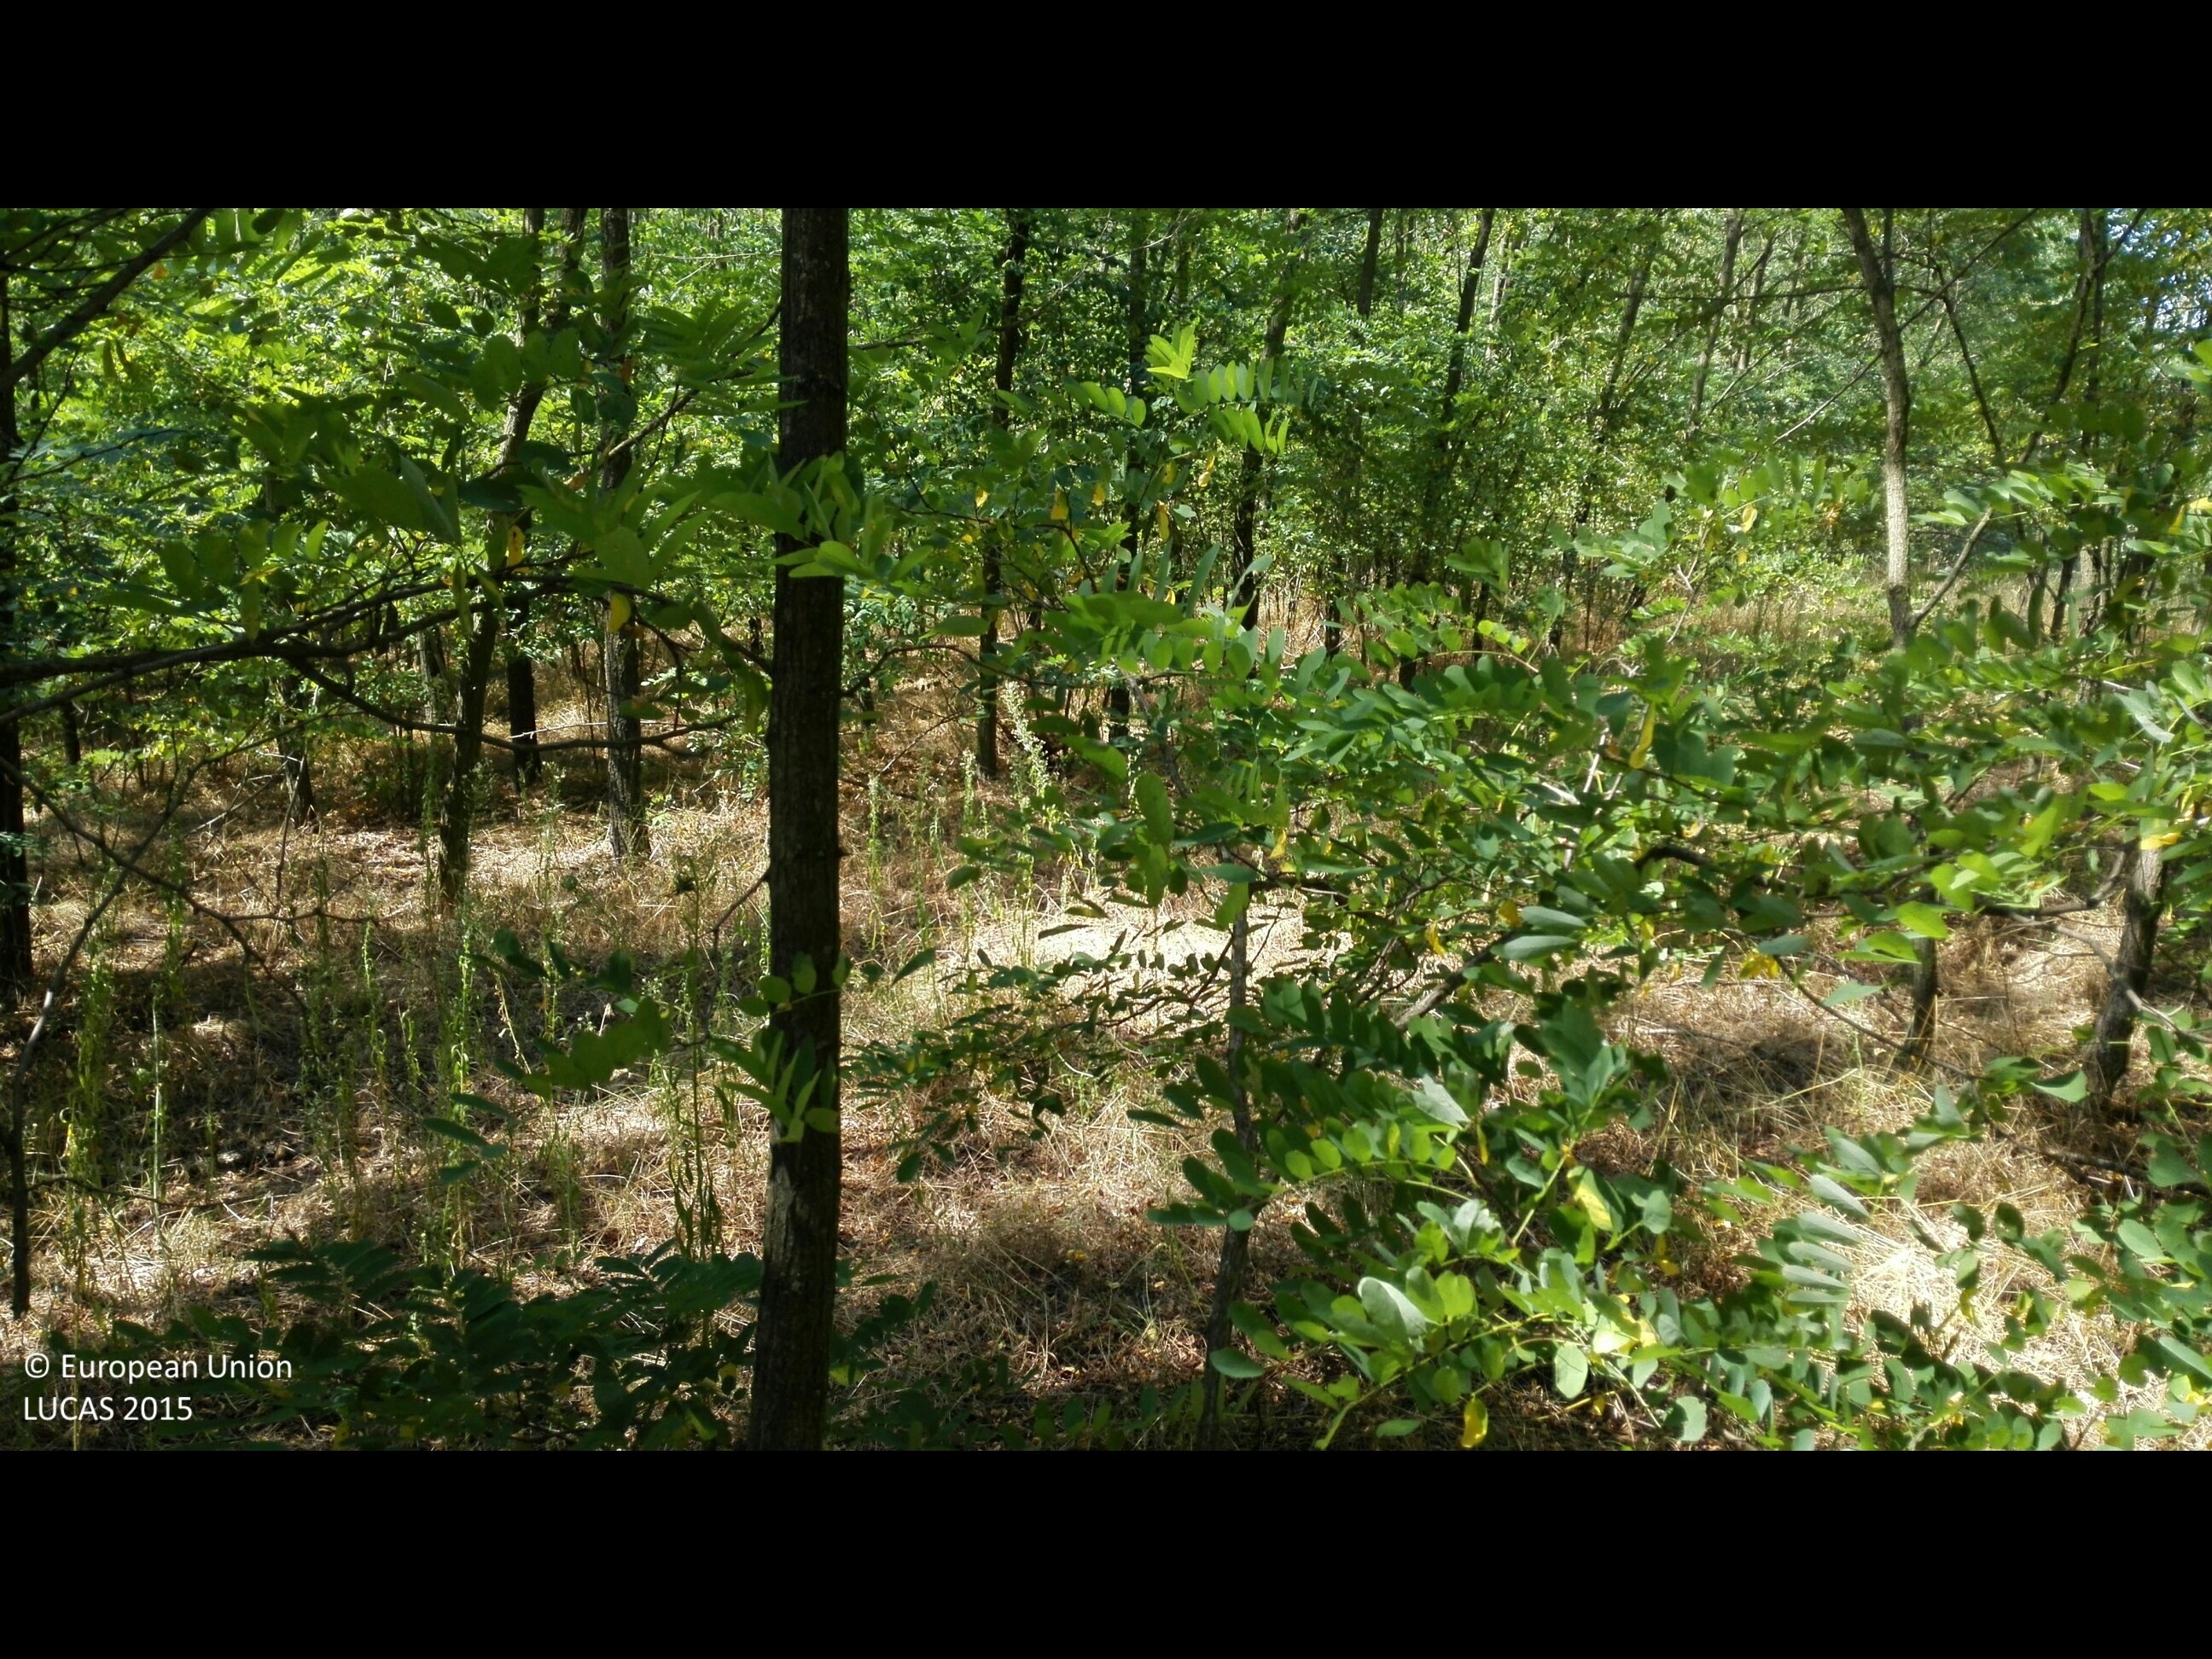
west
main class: Woodland
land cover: Broadleaved woodland
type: exotic forest
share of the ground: > 75 %
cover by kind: broadleaved forest trees 95 %, herbaceous plants 5 %
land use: Forestry
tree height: > 5 m
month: August
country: HU
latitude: 47.4706
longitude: 21.8693
